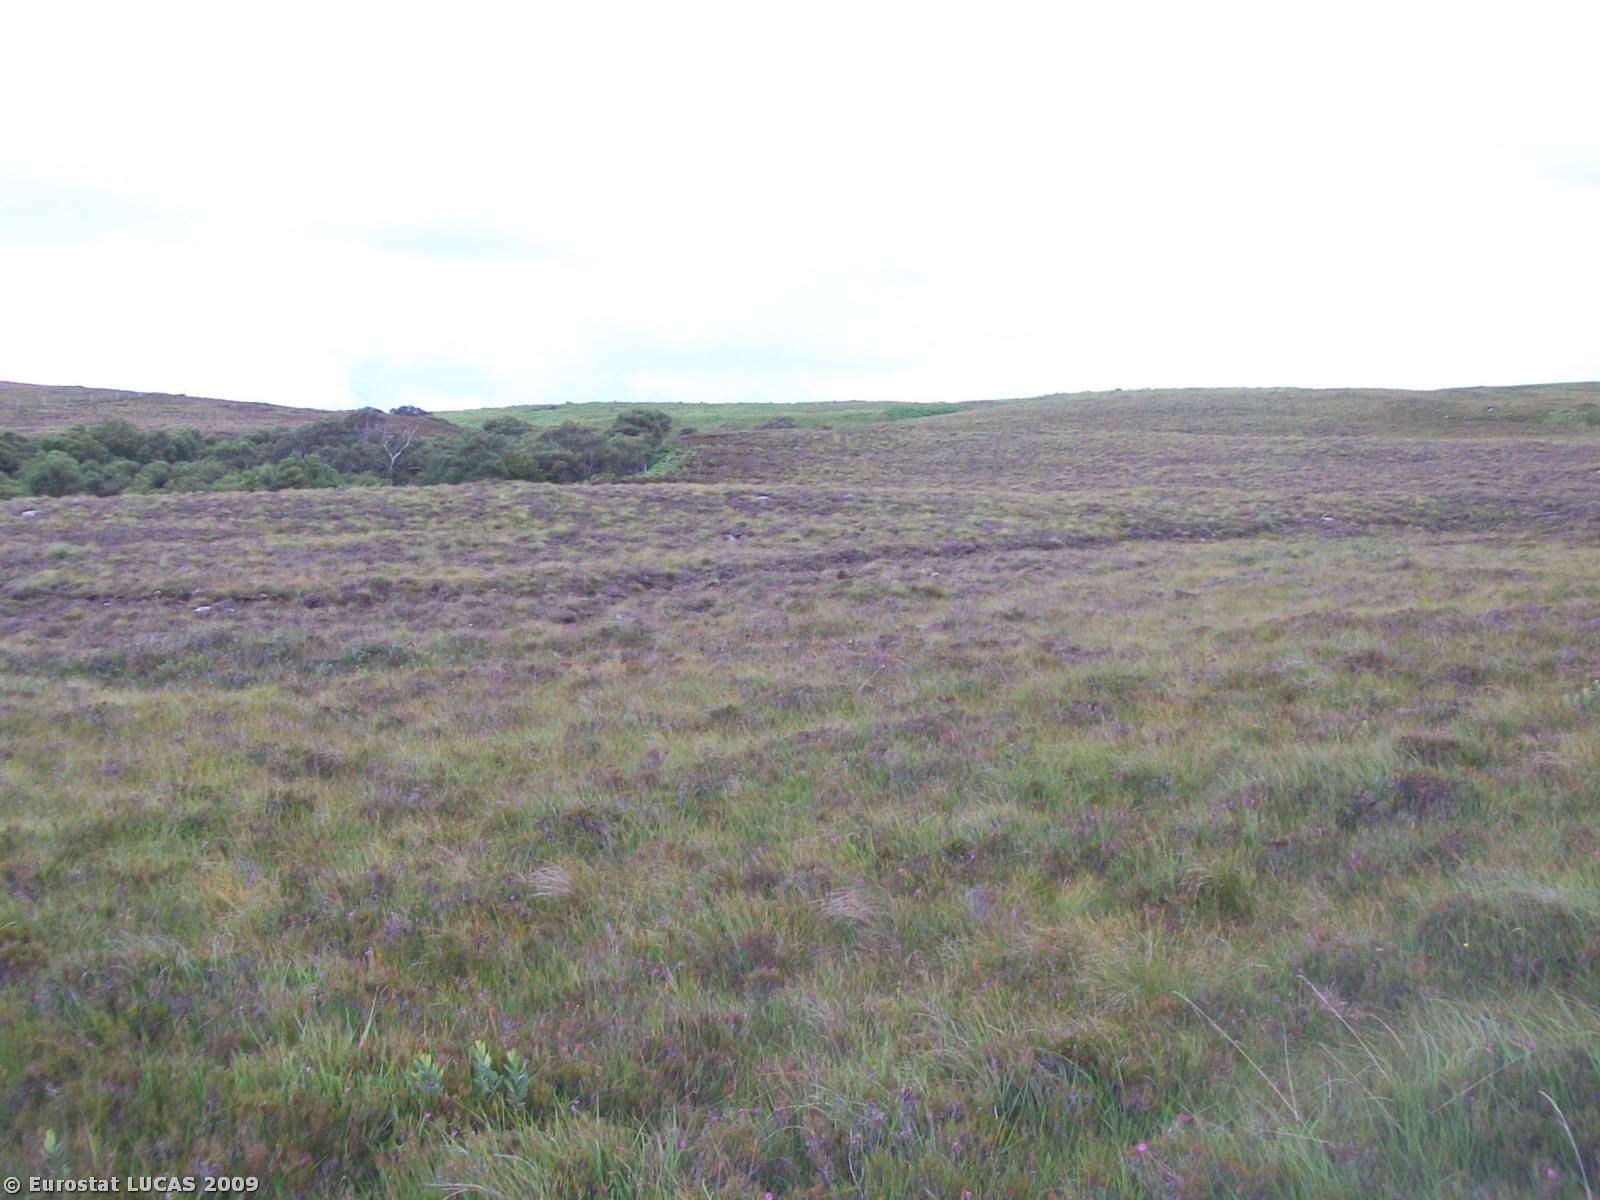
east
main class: Shrubland
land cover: Shrubland without tree cover
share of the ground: > 75 %
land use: Agriculture (excluding fallow land and kitchen gardens)
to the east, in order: Shrubland without tree cover
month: July
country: GB
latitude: 58.4779
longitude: -4.6124
